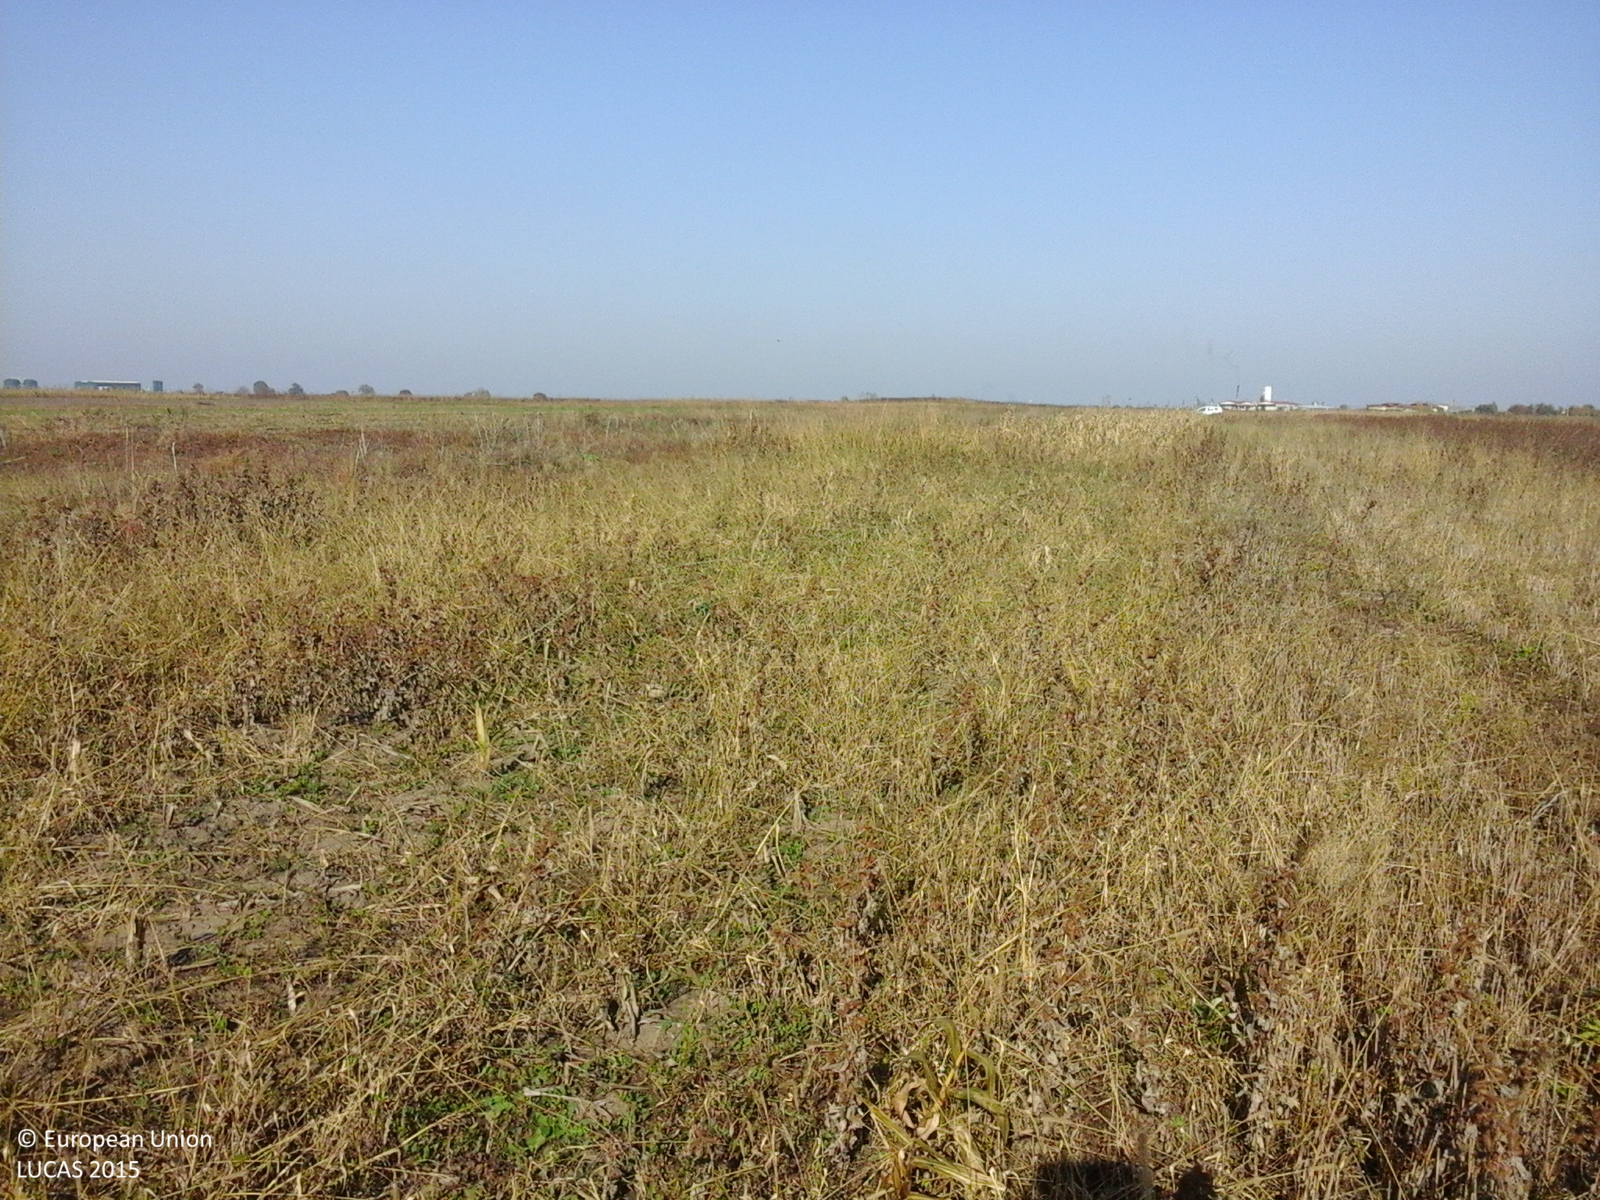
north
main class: Cropland
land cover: Maize
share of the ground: 25 - 50 %
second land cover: Spontaneously vegetated surfaces
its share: > 75 %
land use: Agriculture (excluding fallow land and kitchen gardens)
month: October
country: RO
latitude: 45.7263
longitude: 27.1448
